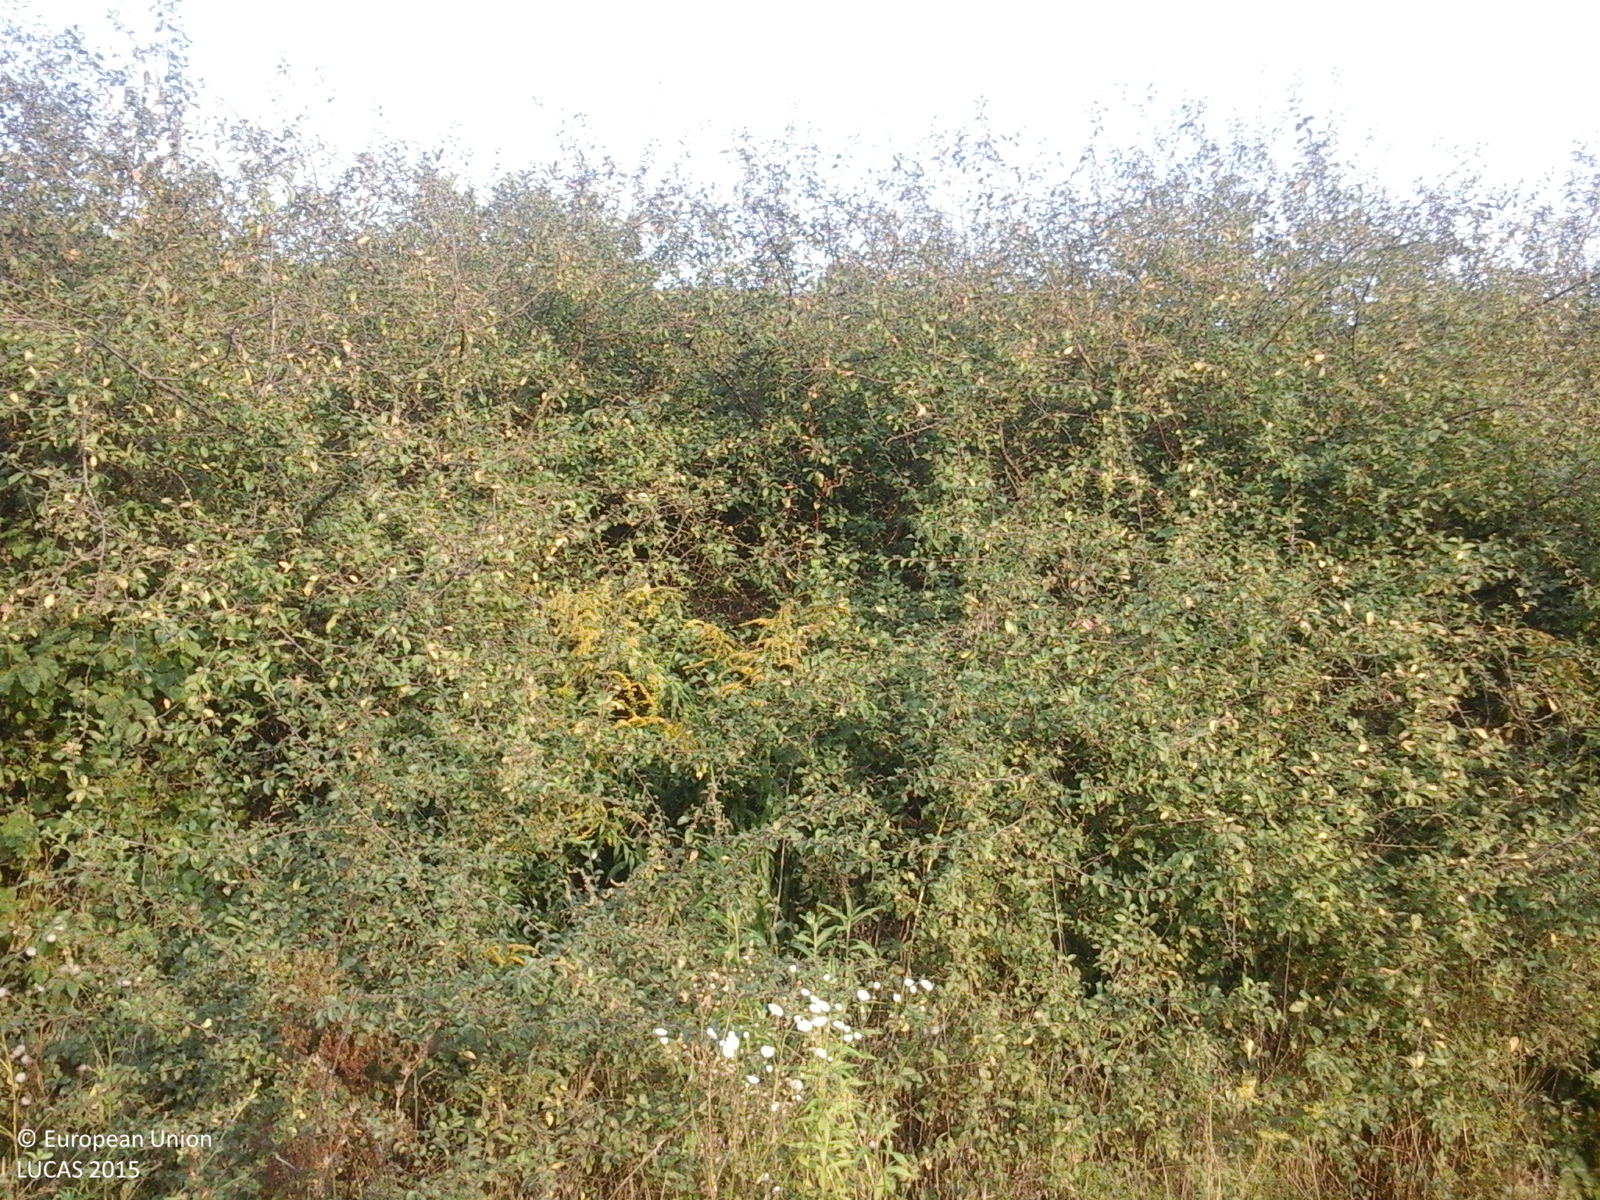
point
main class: Shrubland
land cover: Shrubland with sparse tree cover
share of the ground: > 75 %
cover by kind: shrubs 95 %, broadleaved forest trees 5 %
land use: Fallow land
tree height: > 5 m
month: September
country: RO
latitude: 47.0065
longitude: 24.1969
